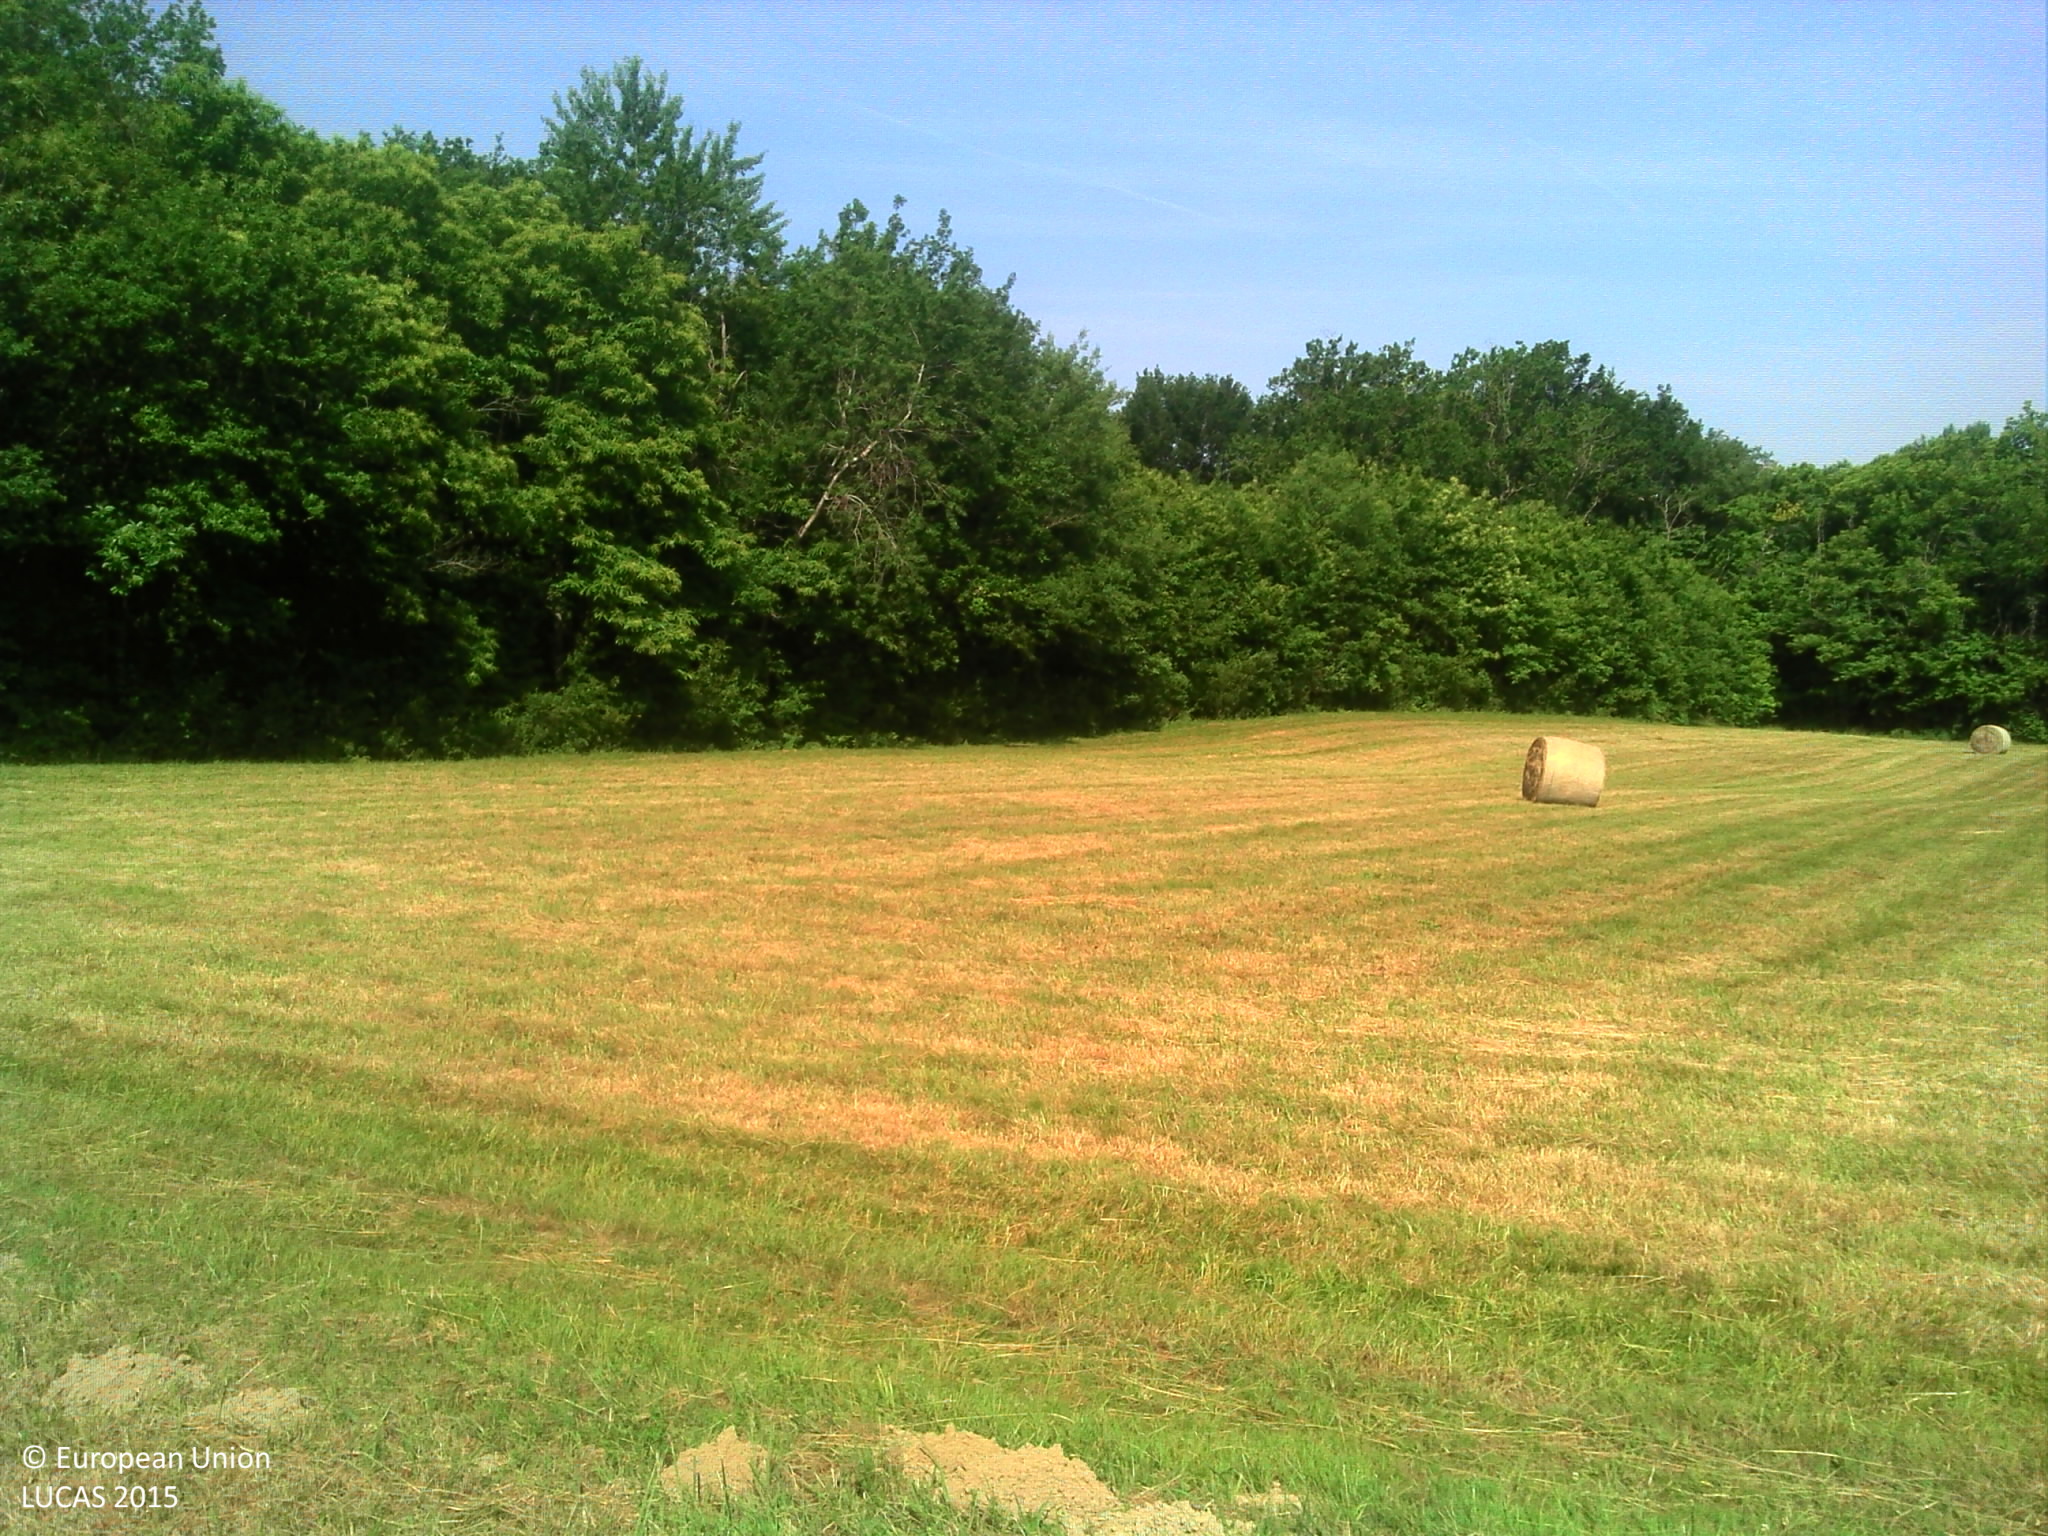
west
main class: Grassland
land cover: Grassland without tree/shrub cover
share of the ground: > 75 %
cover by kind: herbaceous plants 100 %
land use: Agriculture (excluding fallow land and kitchen gardens)
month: June
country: FR
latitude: 43.9624
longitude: 1.6890
